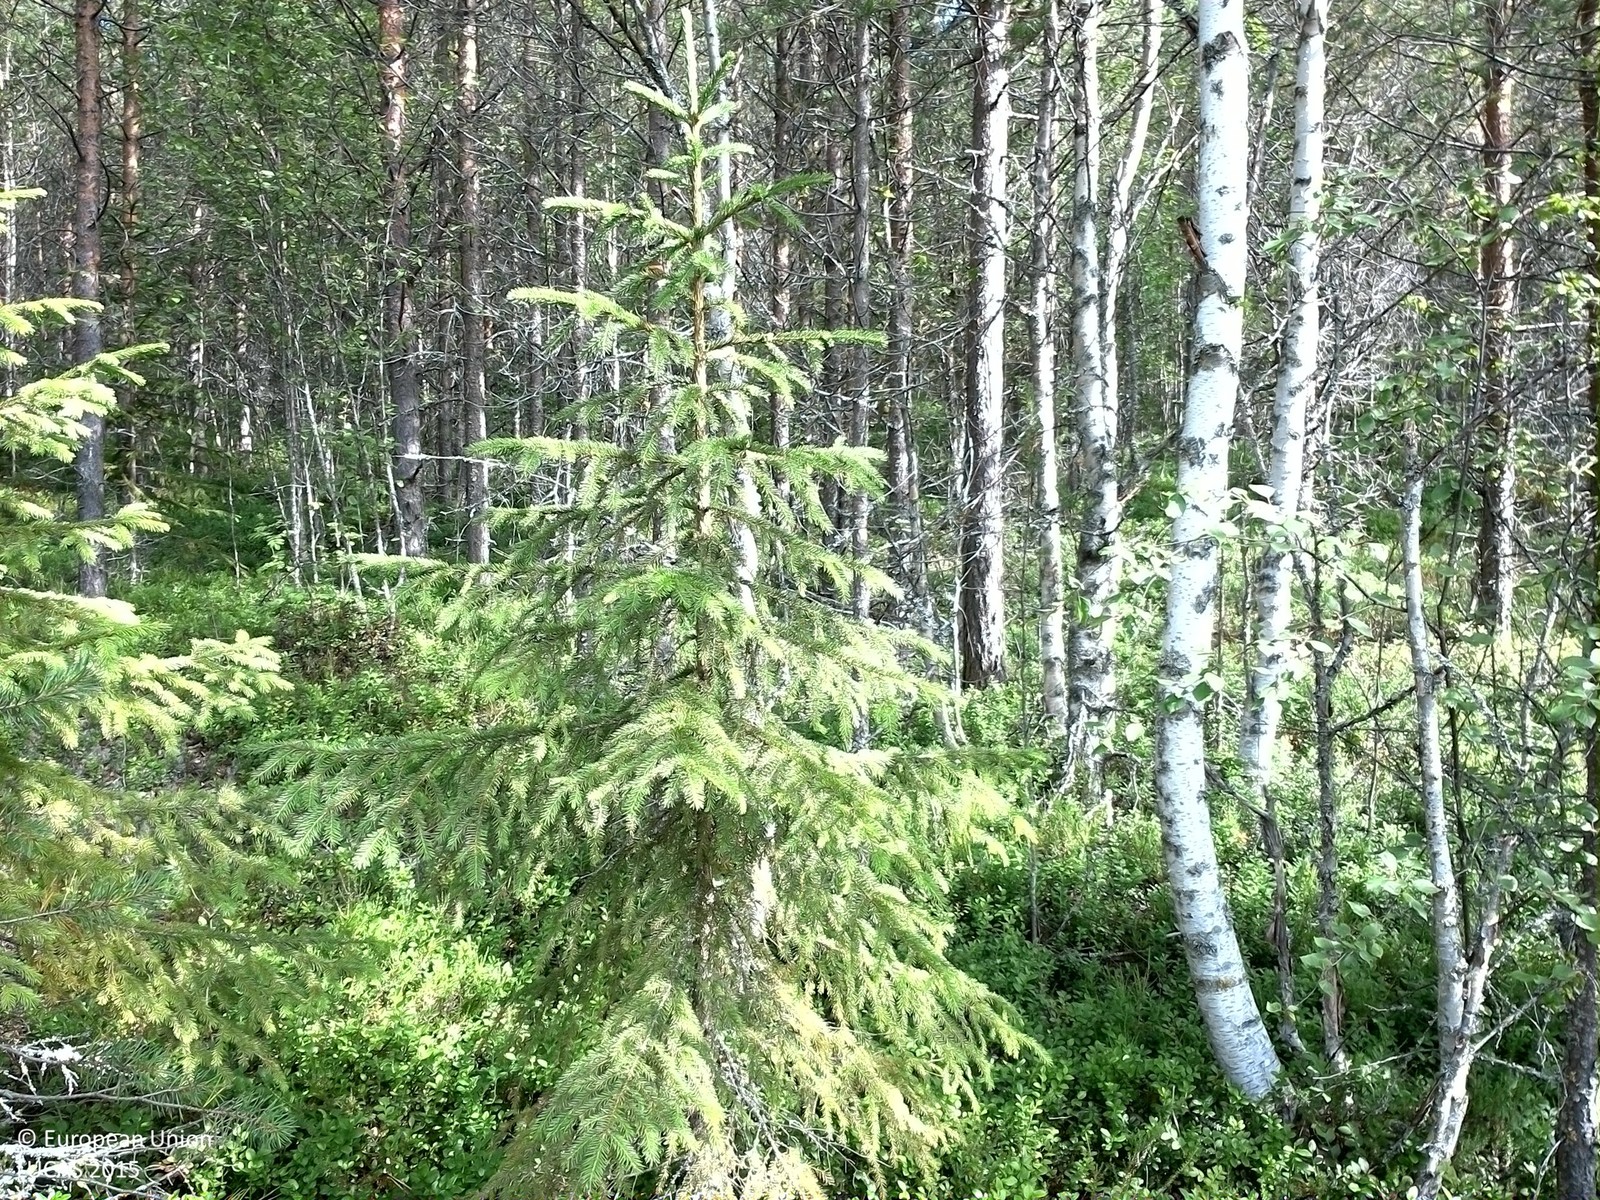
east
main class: Woodland
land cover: Pine dominated coniferous woodland
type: boreal forest
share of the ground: 50 - 75 %
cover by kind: coniferous forest trees 55 %, shrubs 25 %, broadleaved forest trees 10 %, lichens and mosses 10 %
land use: Forestry
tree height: > 5 m
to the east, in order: Pine dominated coniferous woodland
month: August
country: SE
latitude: 63.7944
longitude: 16.4874
